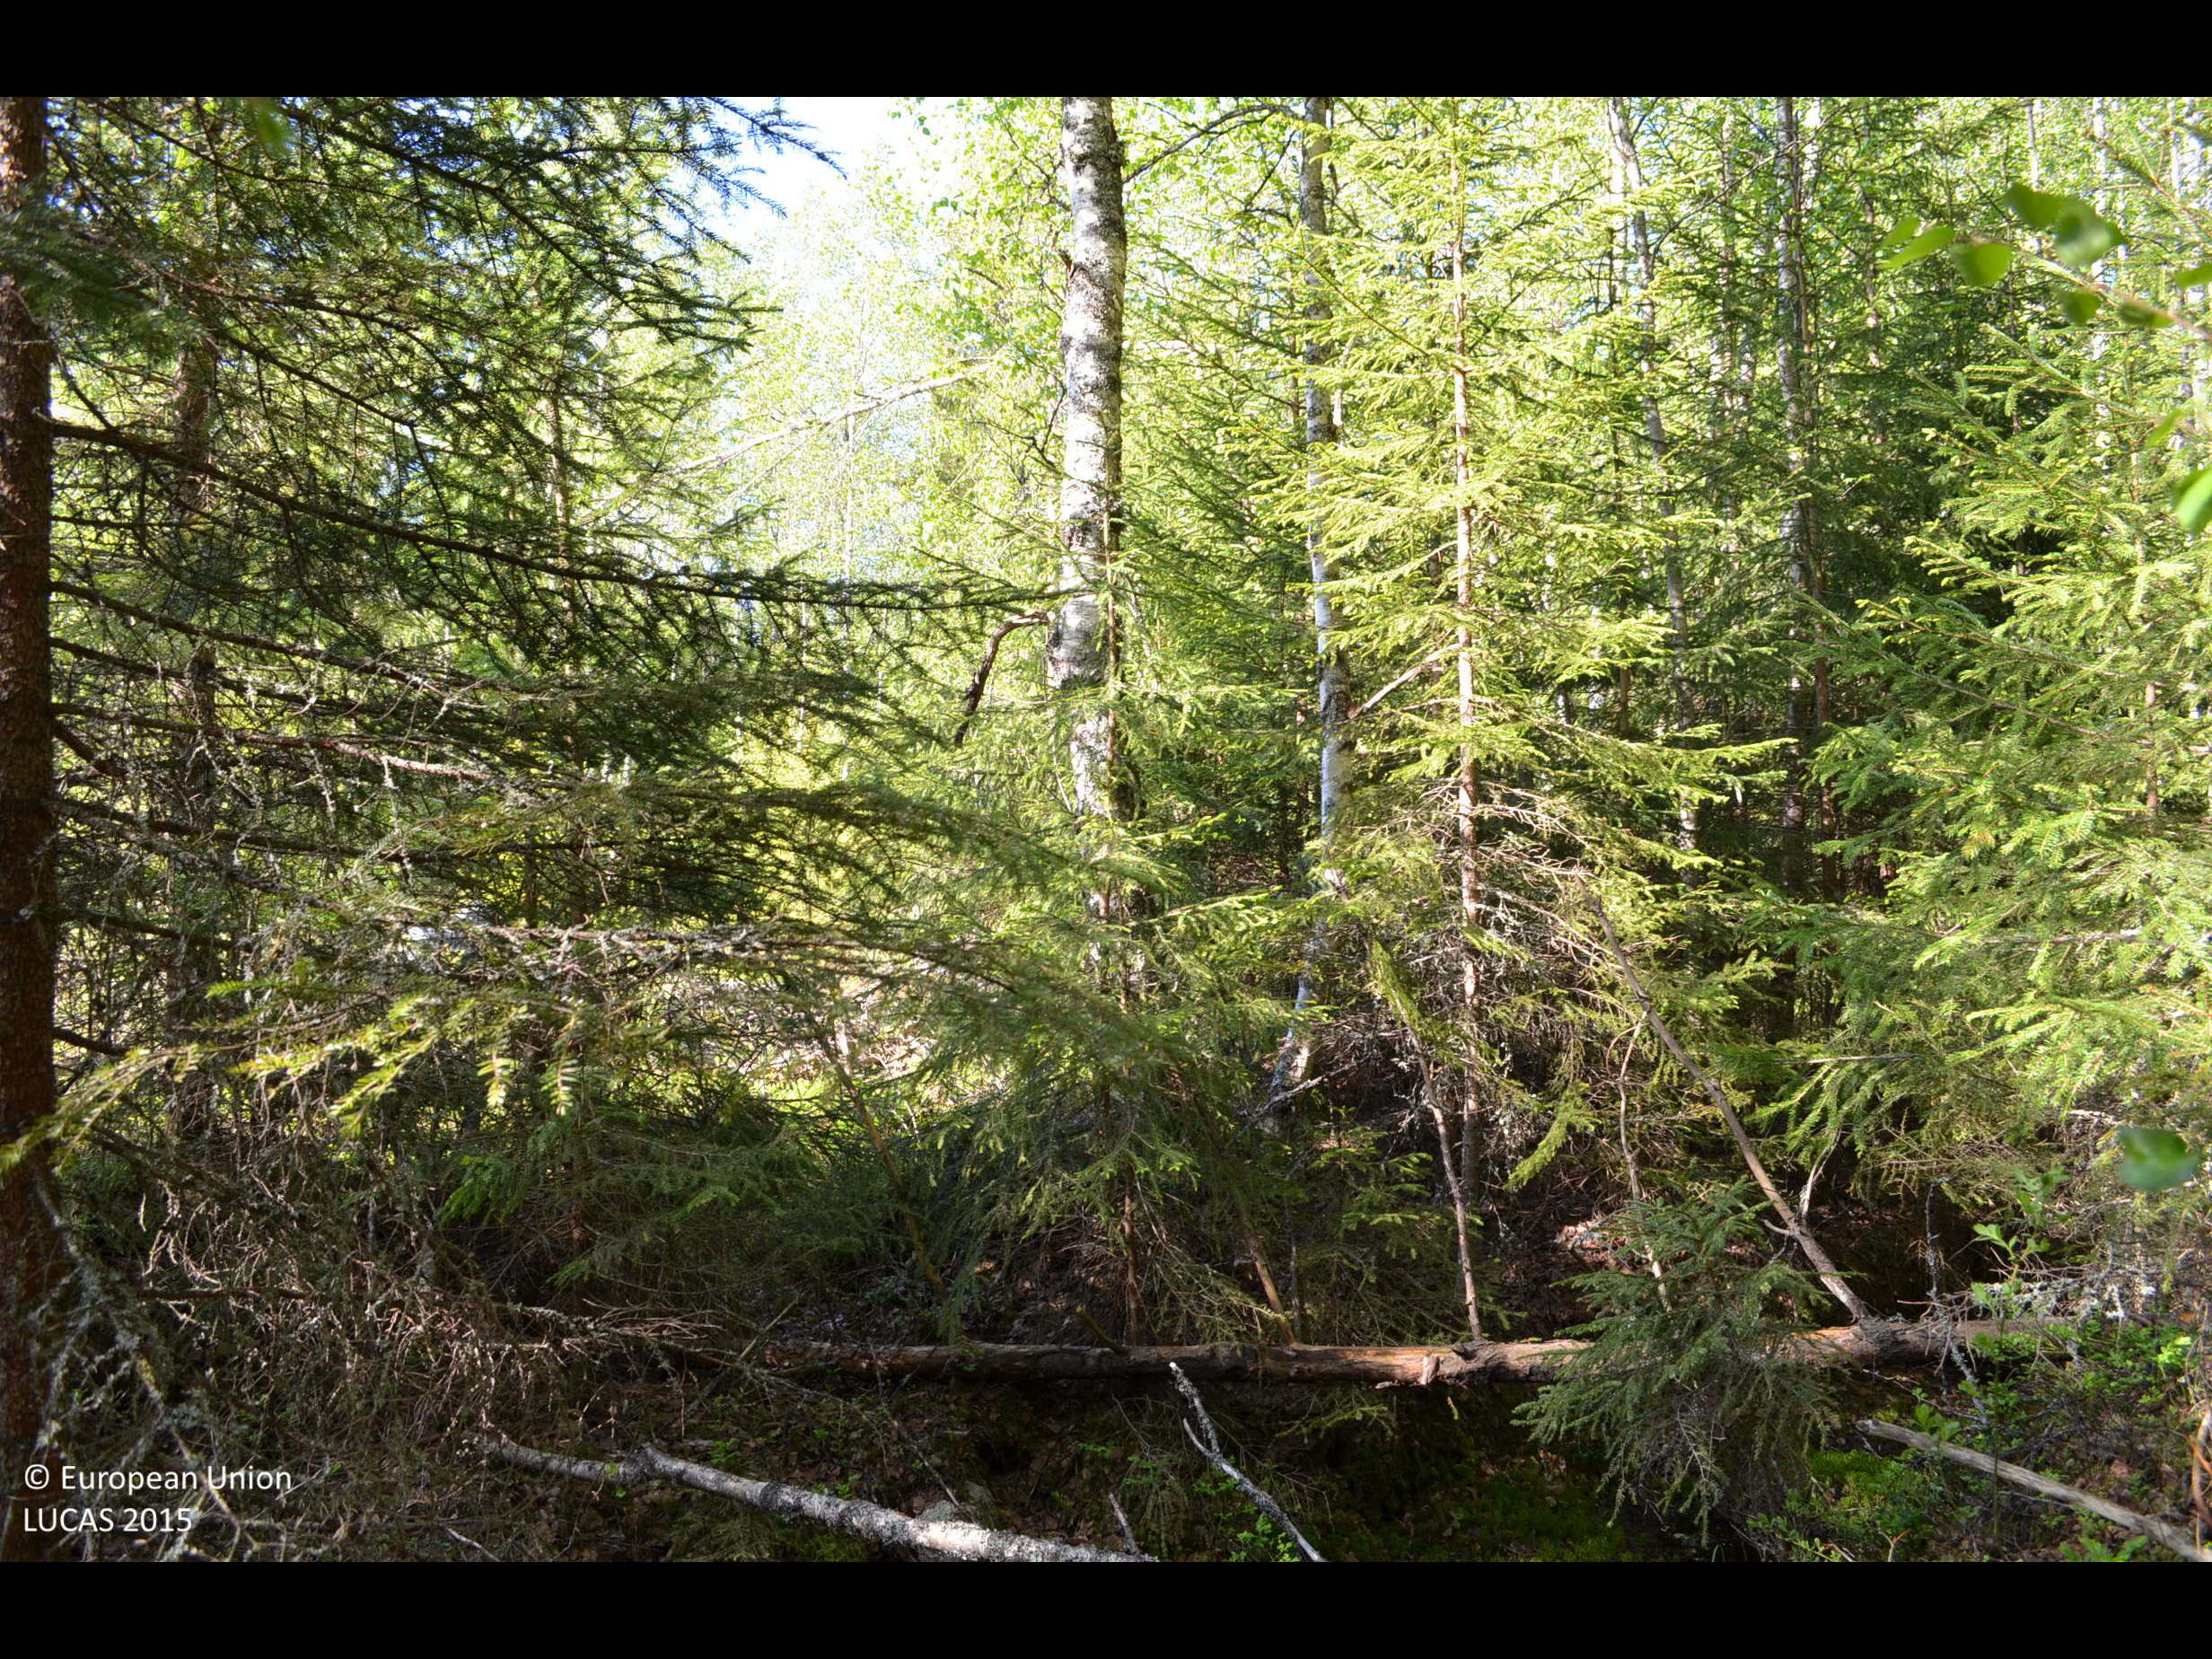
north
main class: Woodland
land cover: Pine dominated mixed woodland
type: boreal forest
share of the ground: > 75 %
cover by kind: coniferous forest trees 60 %, broadleaved forest trees 25 %, shrubs 10 %, lichens and mosses 5 %
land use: Forestry
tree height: > 5 m
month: June
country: FI
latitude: 61.8978
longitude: 23.2213
